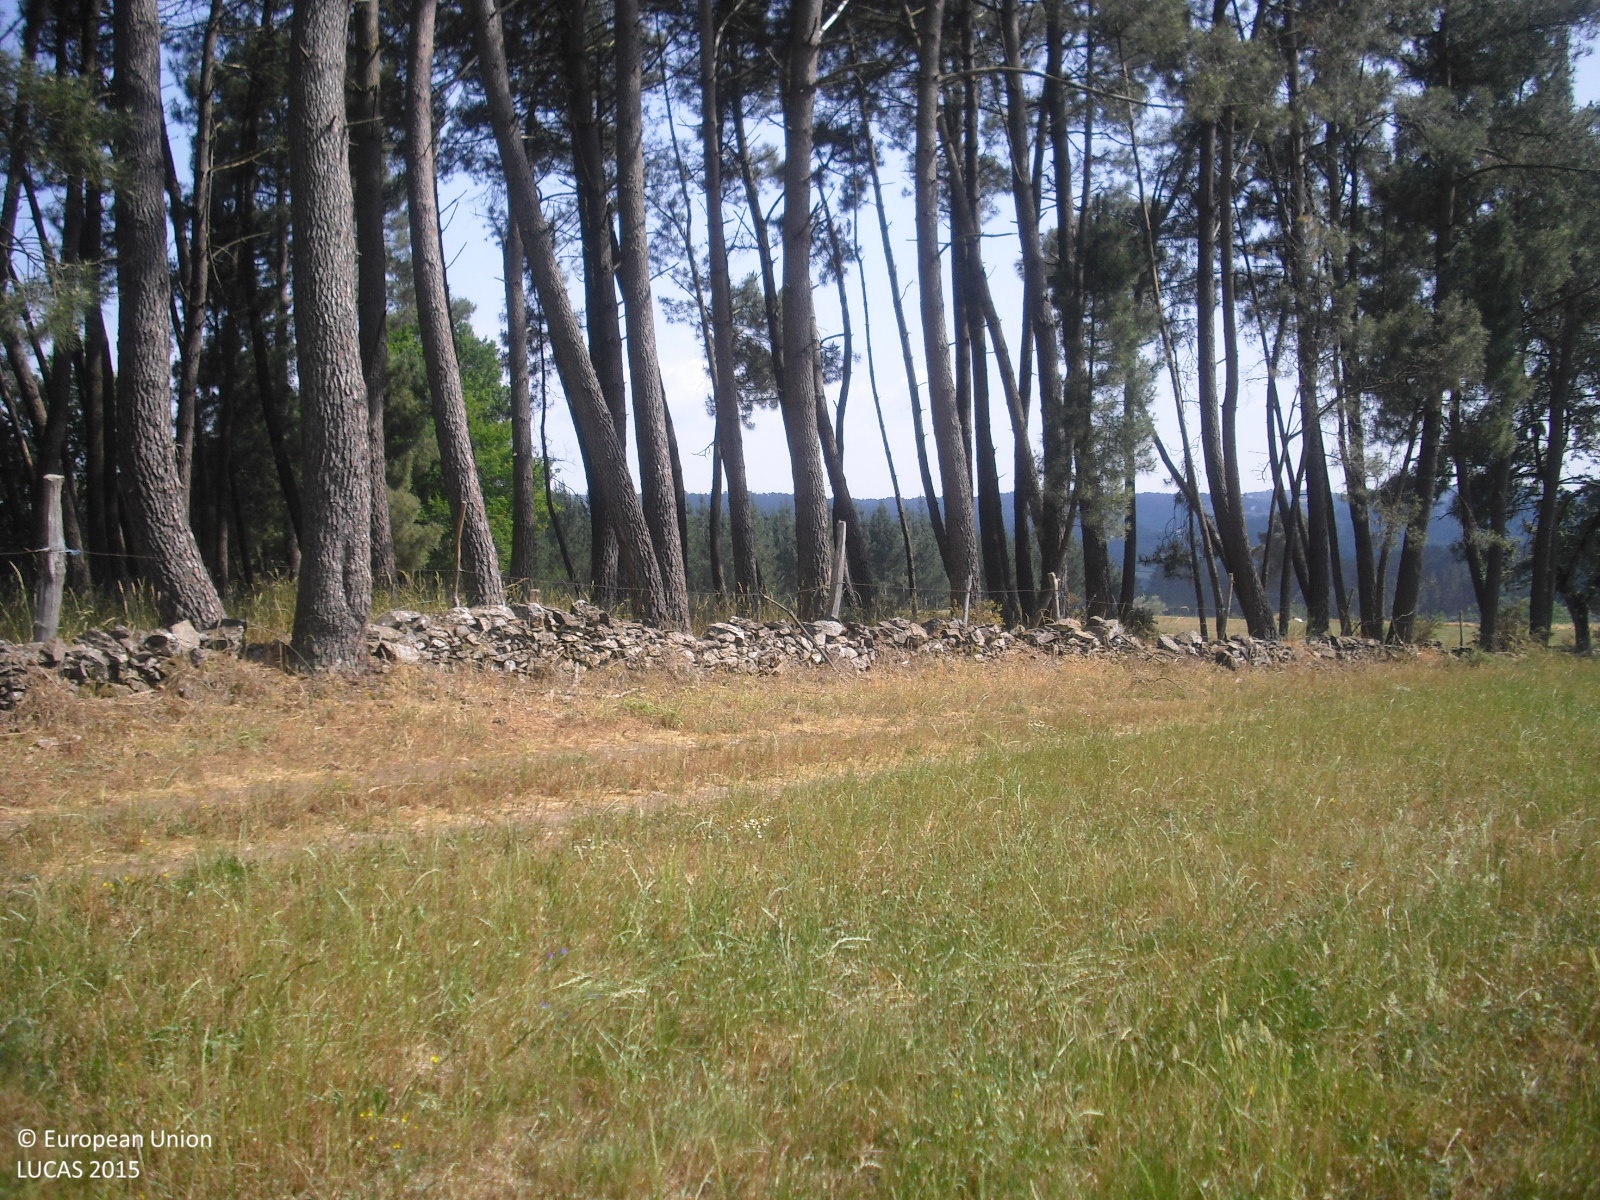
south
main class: Cropland
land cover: Temporary grasslands
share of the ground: > 75 %
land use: Agriculture (excluding fallow land and kitchen gardens)
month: June
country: ES
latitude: 42.6091
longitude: -7.8154
